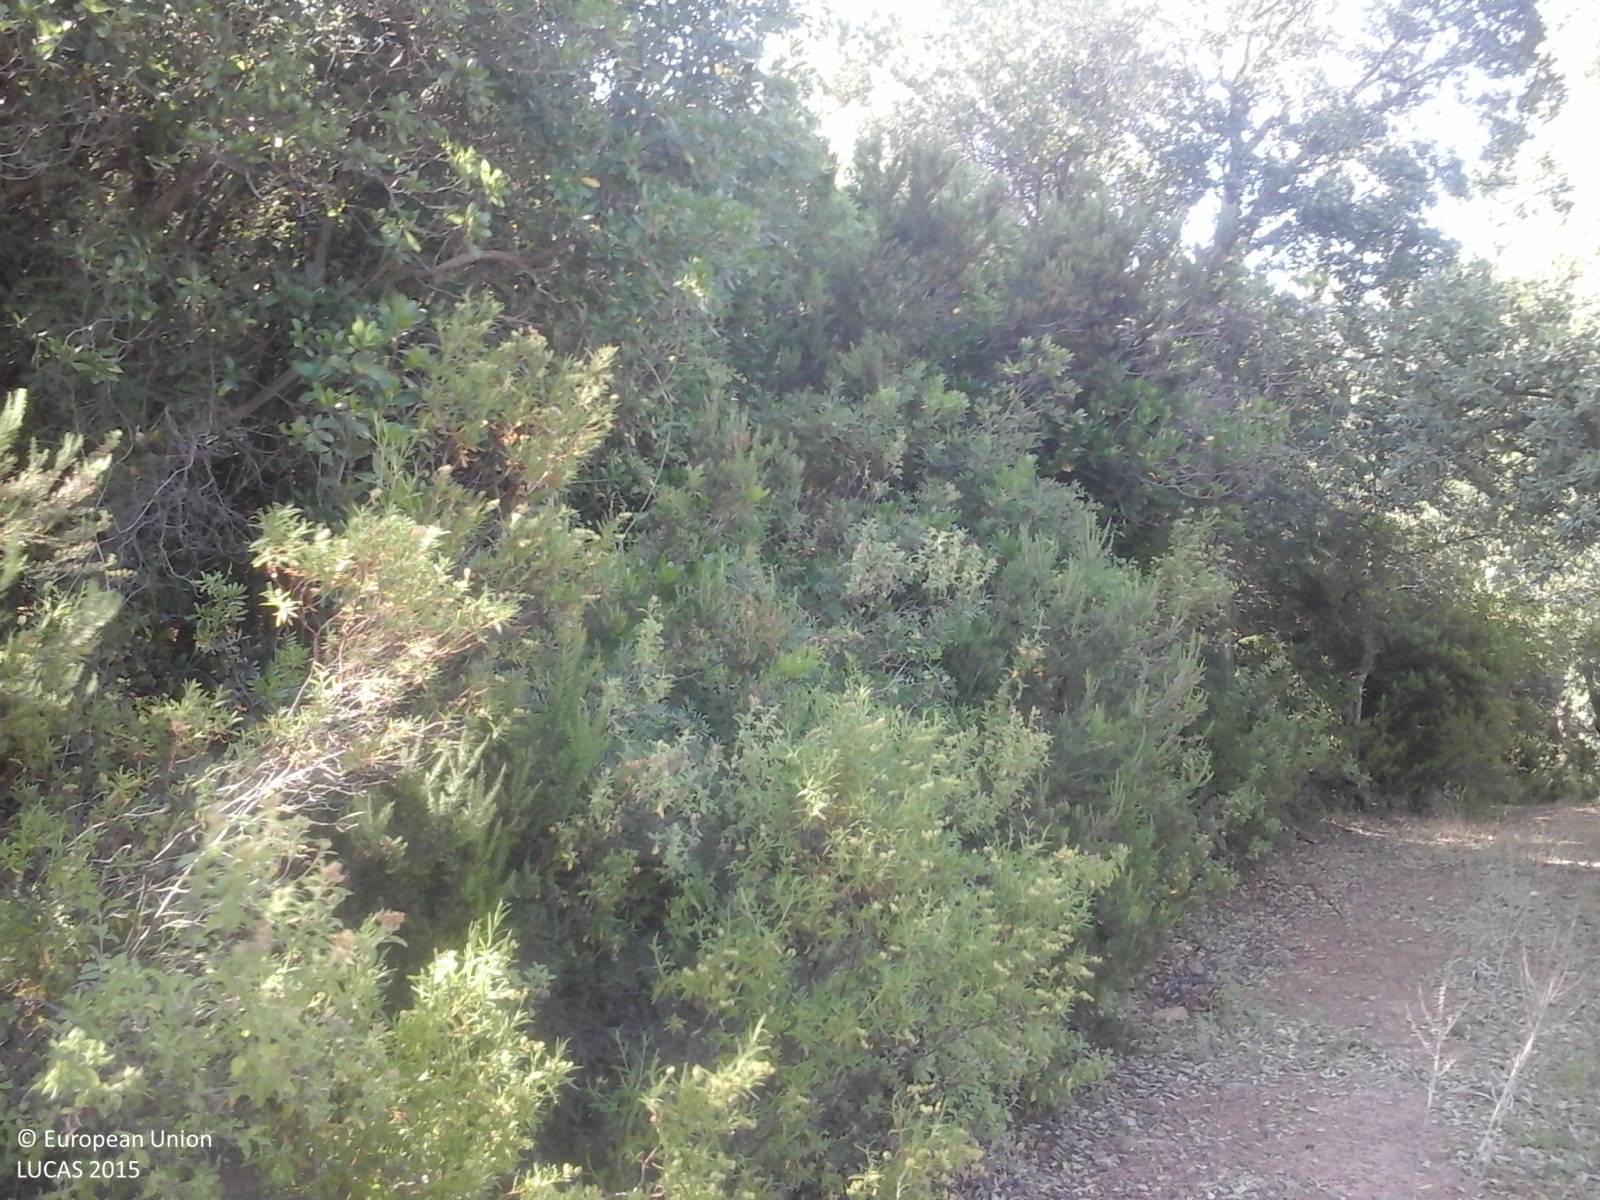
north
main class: Shrubland
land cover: Shrubland with sparse tree cover
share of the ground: > 75 %
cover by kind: shrubs 95 %, broadleaved forest trees 5 %
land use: Semi-natural and natural areas not in use
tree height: > 5 m
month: June
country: IT
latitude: 39.1909
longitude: 8.7688
